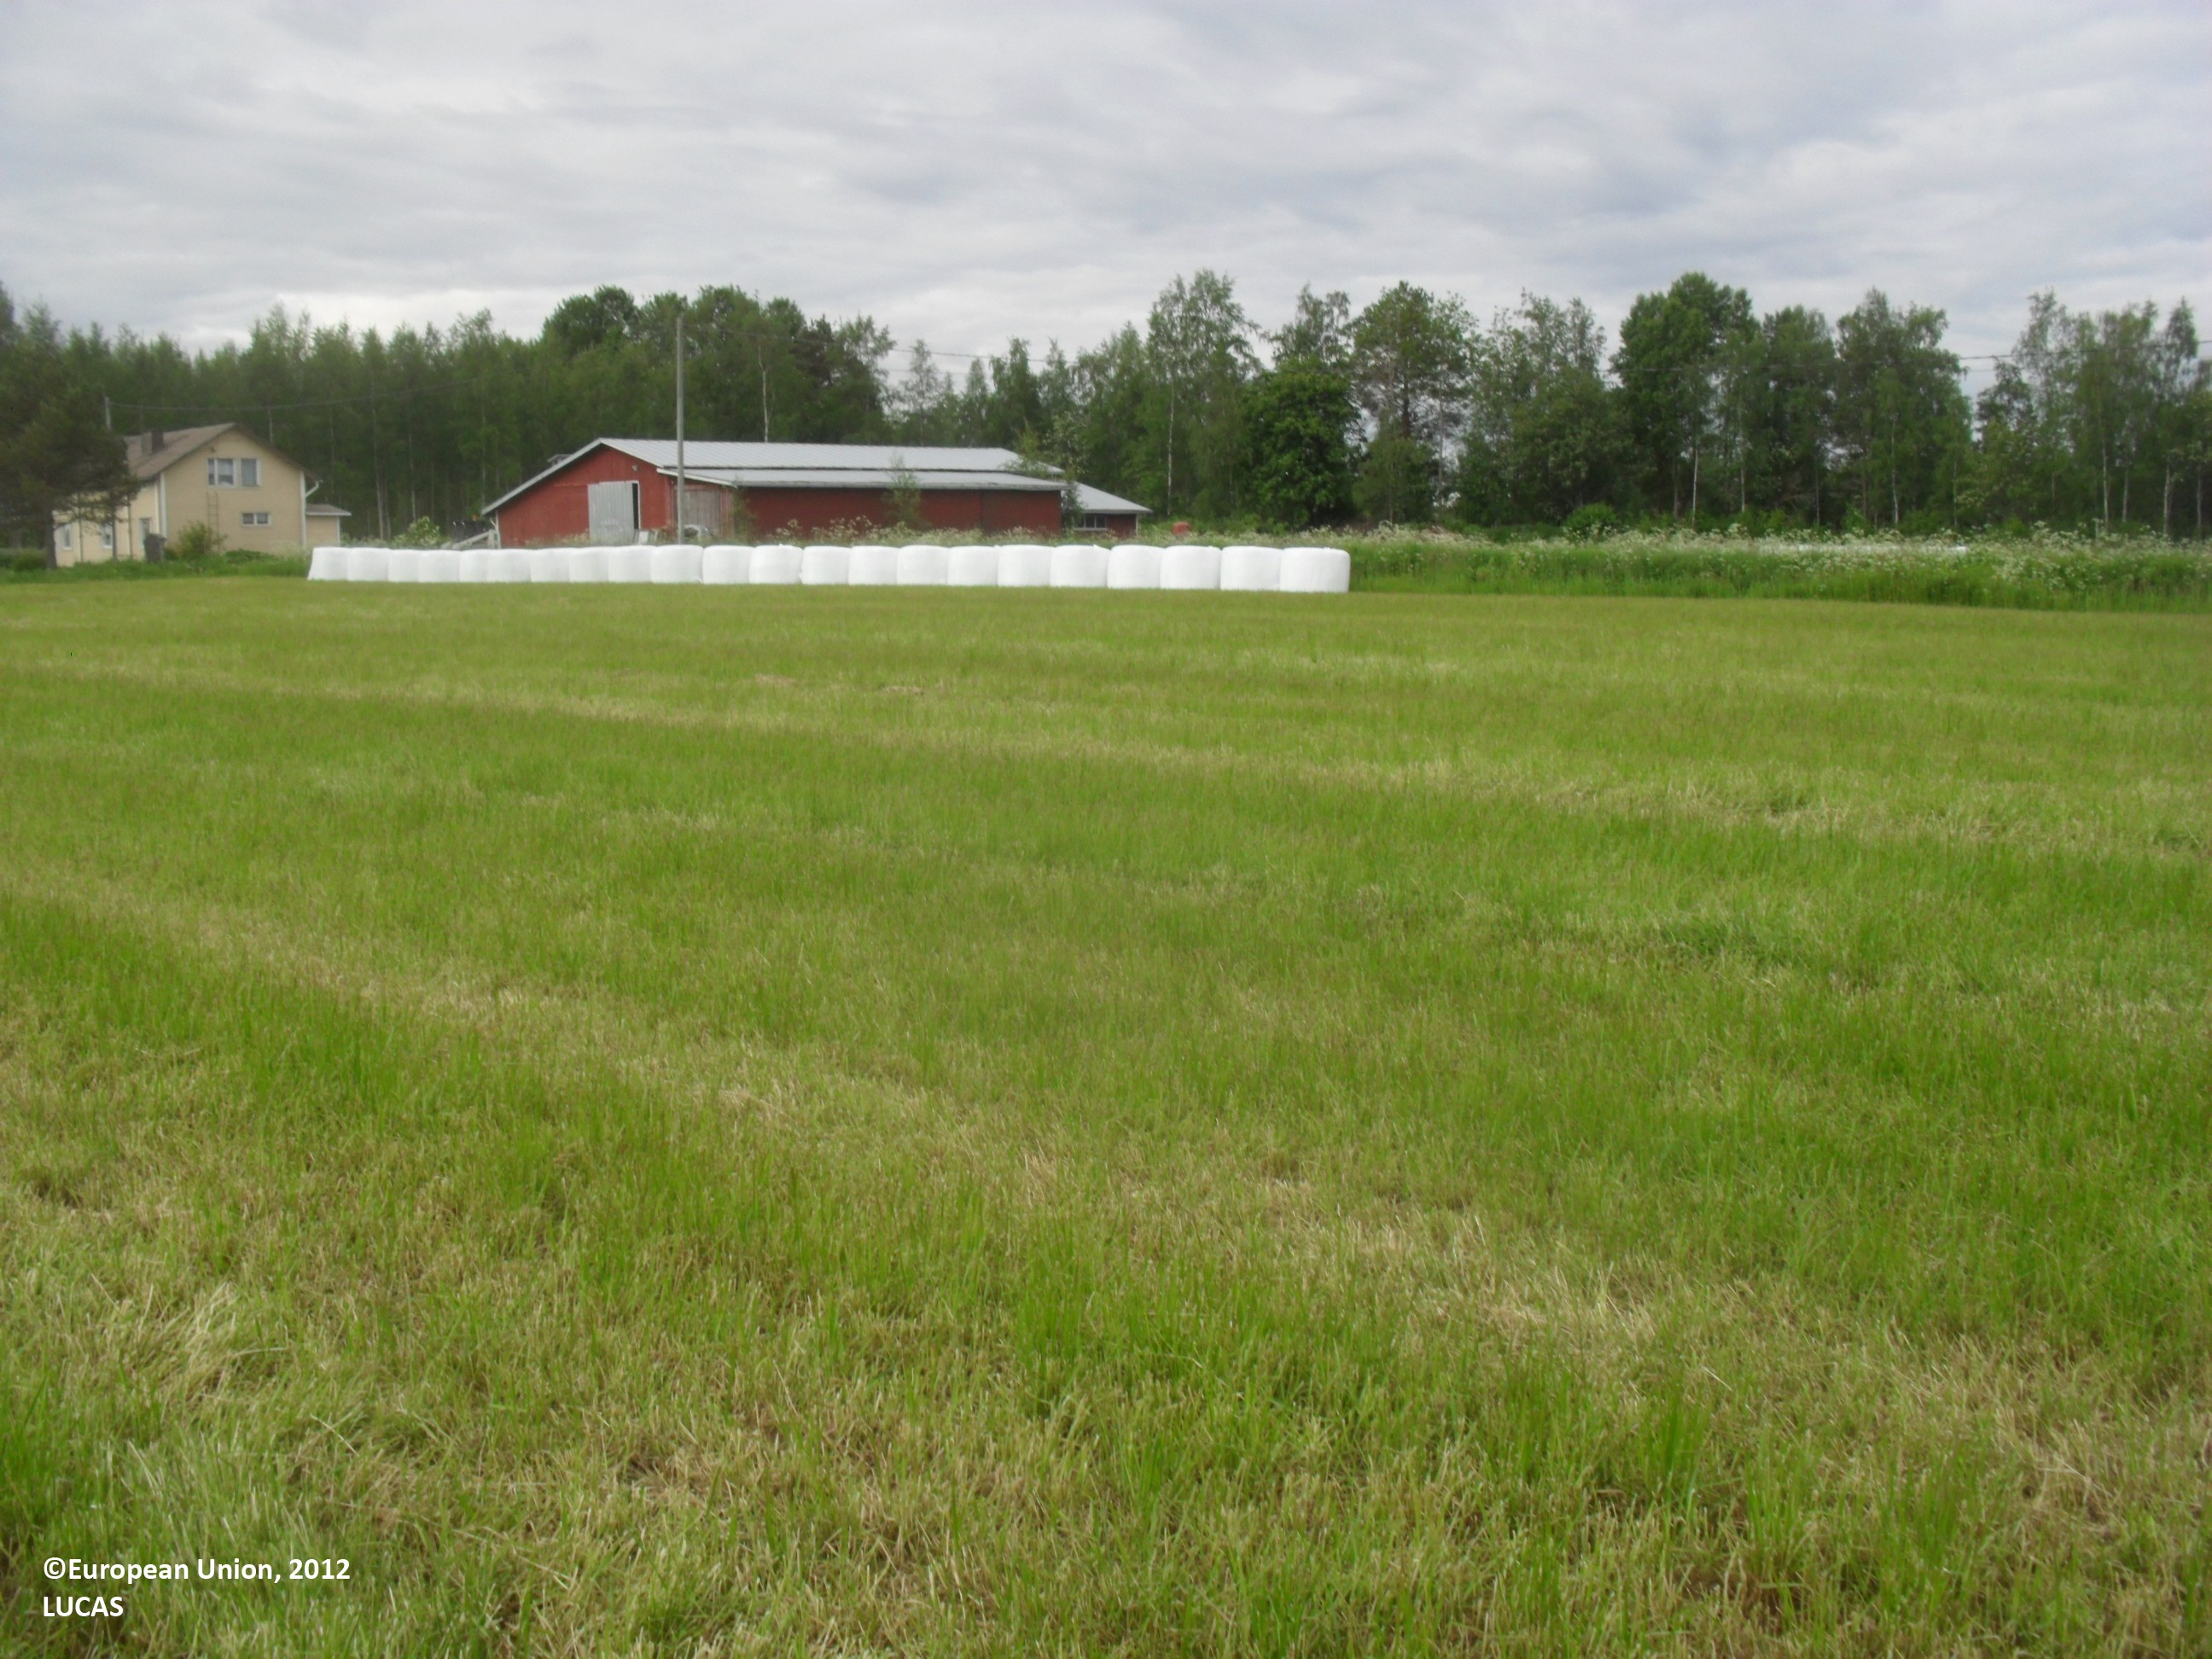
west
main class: Cropland
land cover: Temporary grasslands
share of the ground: > 75 %
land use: Agriculture (excluding fallow land and kitchen gardens)
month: June
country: FI
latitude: 63.3290
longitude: 23.4213
